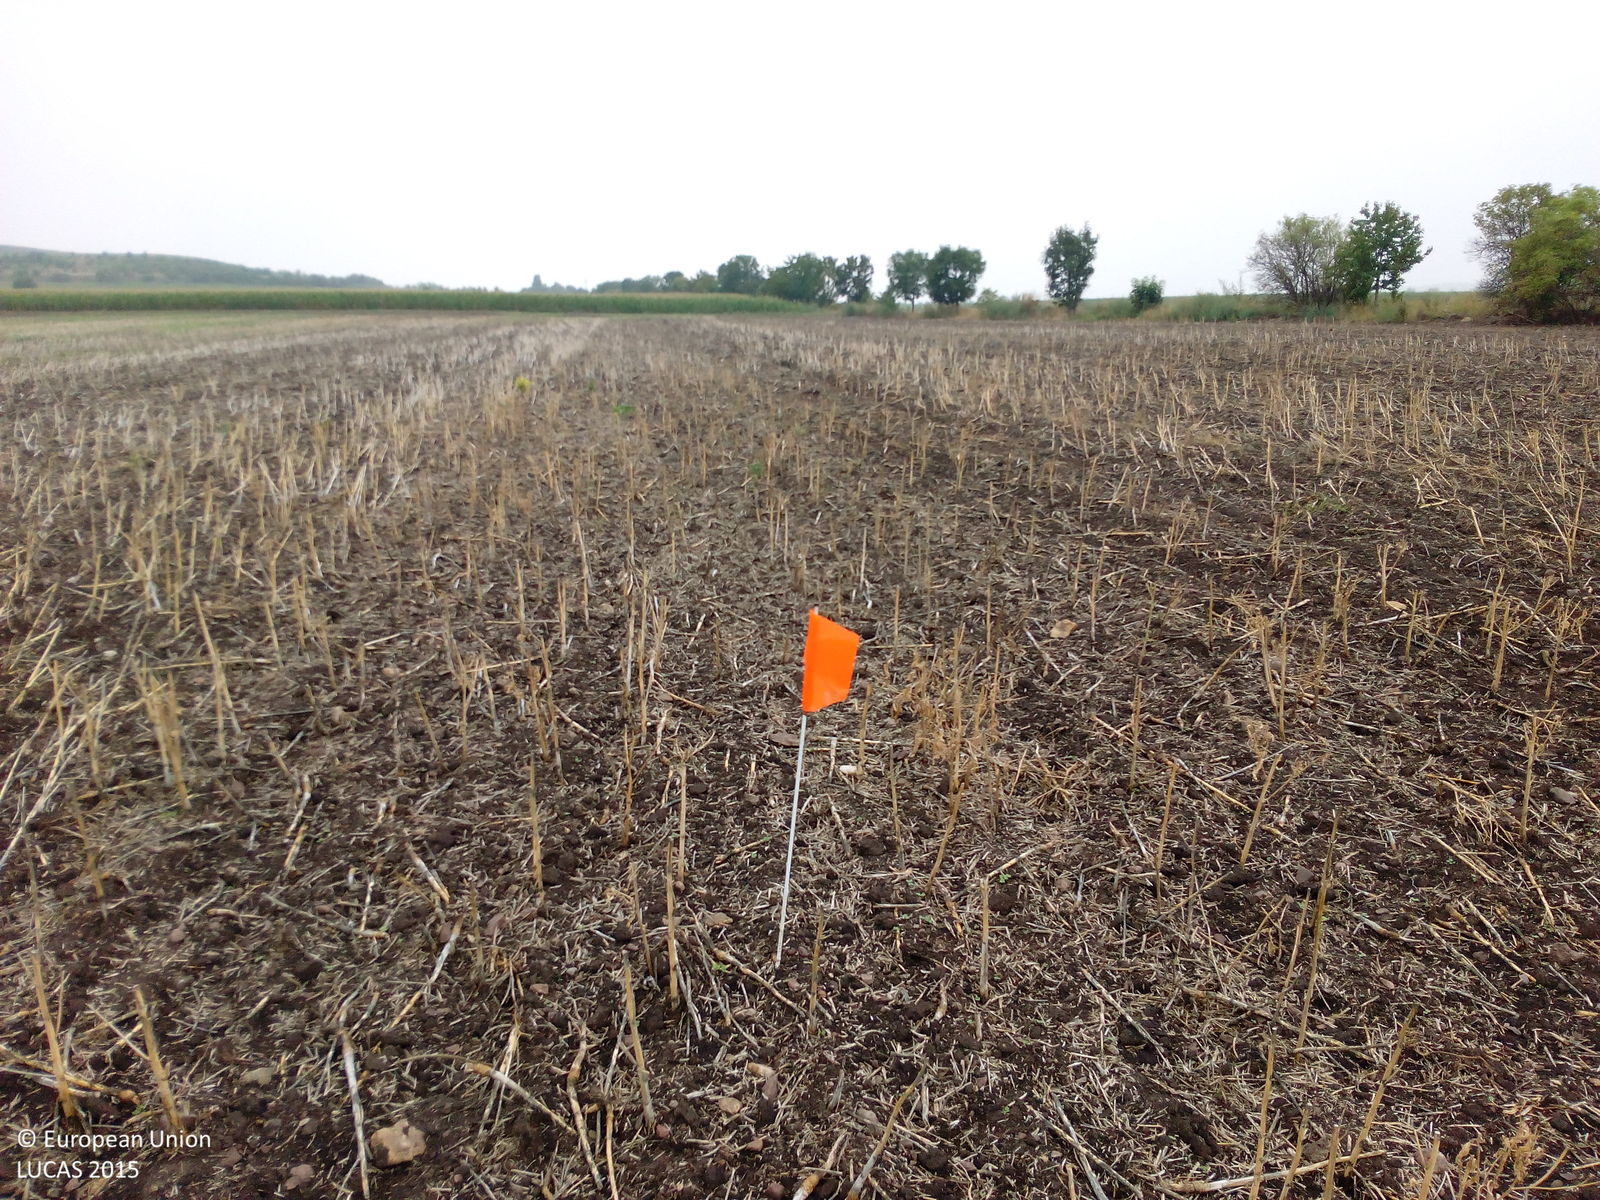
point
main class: Cropland
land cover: Rape and turnip rape
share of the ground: < 10 %
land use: Agriculture (excluding fallow land and kitchen gardens)
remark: Harvested field
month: August
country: DE
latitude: 51.0603
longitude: 11.0698
